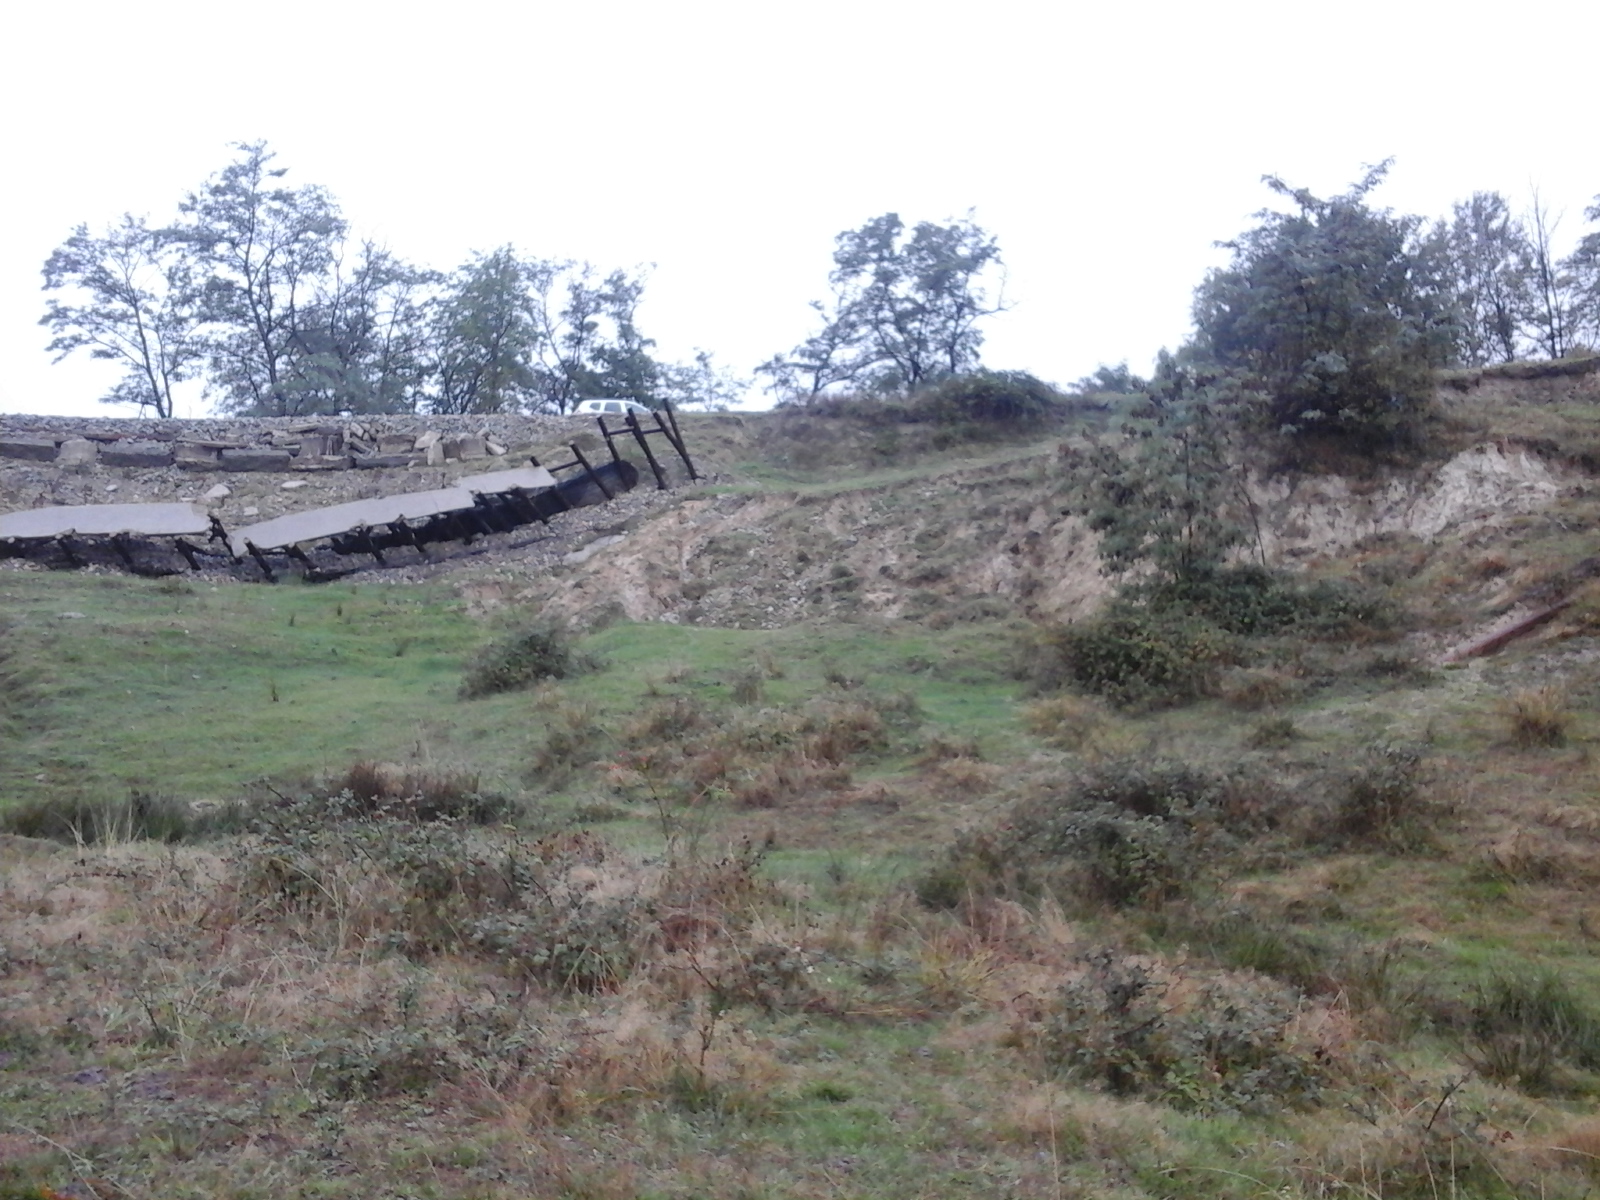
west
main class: Grassland
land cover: Spontaneously vegetated surfaces
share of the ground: > 75 %
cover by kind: herbaceous plants 100 %
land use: Fallow land
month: September
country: RO
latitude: 44.9839
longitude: 23.7456
